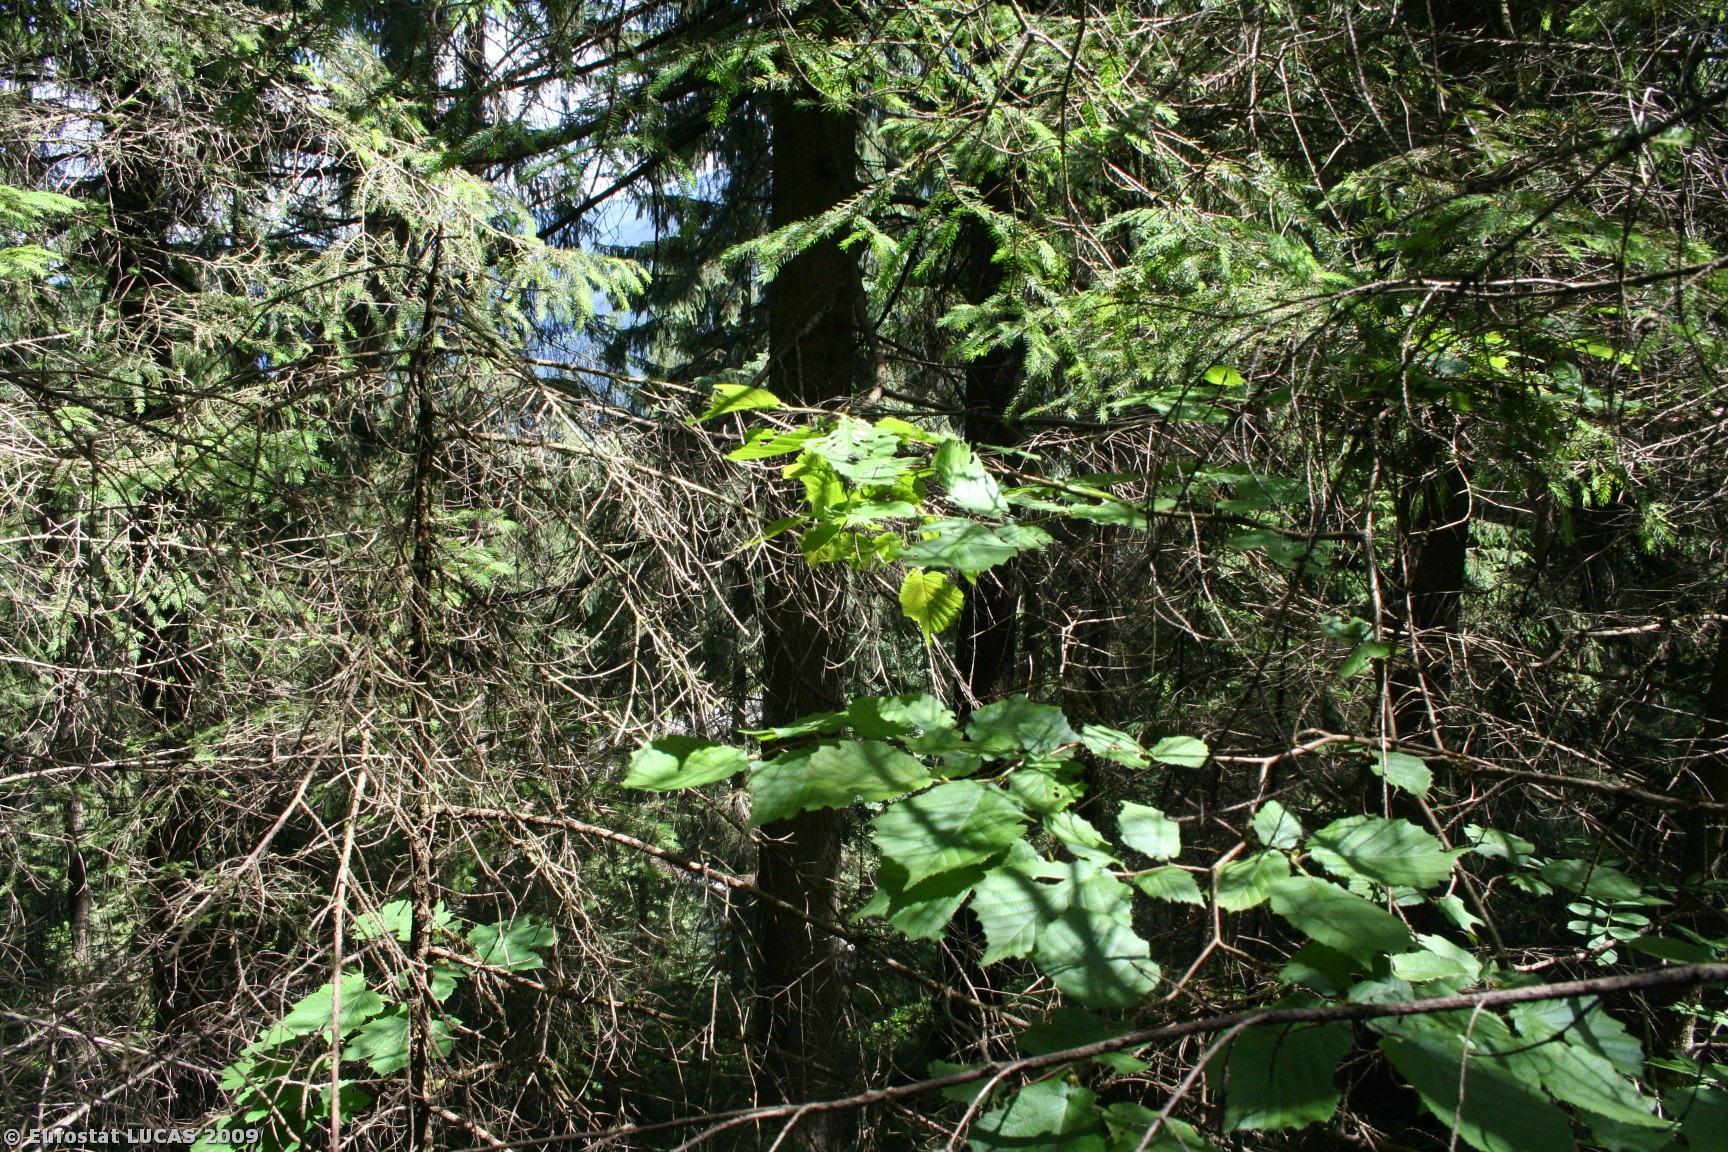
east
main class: Woodland
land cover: Coniferous woodland
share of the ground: 50 - 75 %
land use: Forestry
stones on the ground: < 10 %
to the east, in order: Coniferous woodland; Mixed woodland; Grassland without tree/shrub cover; Paved roads, cycling and walking lanes; Grassland without tree/shrub cover
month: June
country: AT
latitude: 47.2896
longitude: 11.8628
